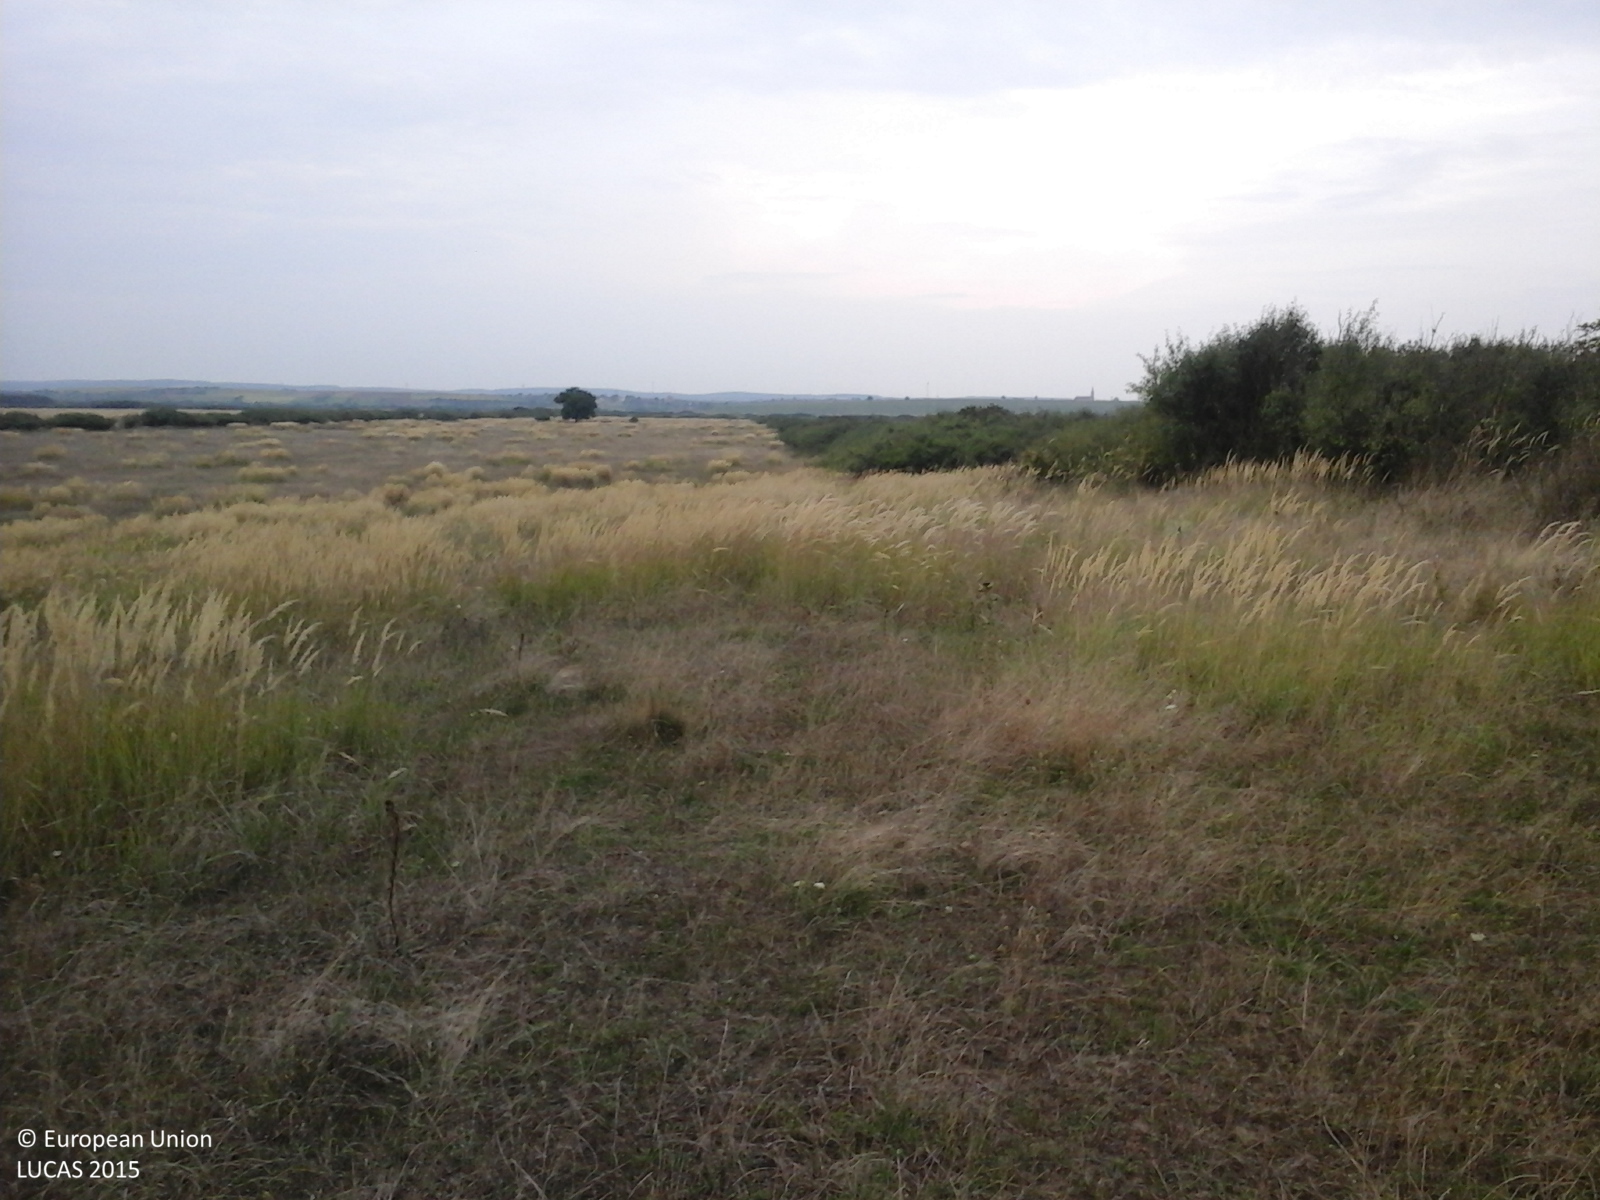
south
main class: Grassland
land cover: Grassland without tree/shrub cover
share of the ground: > 75 %
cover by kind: herbaceous plants 100 %
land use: Agriculture (excluding fallow land and kitchen gardens)
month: August
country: RO
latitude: 46.1037
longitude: 21.5630
